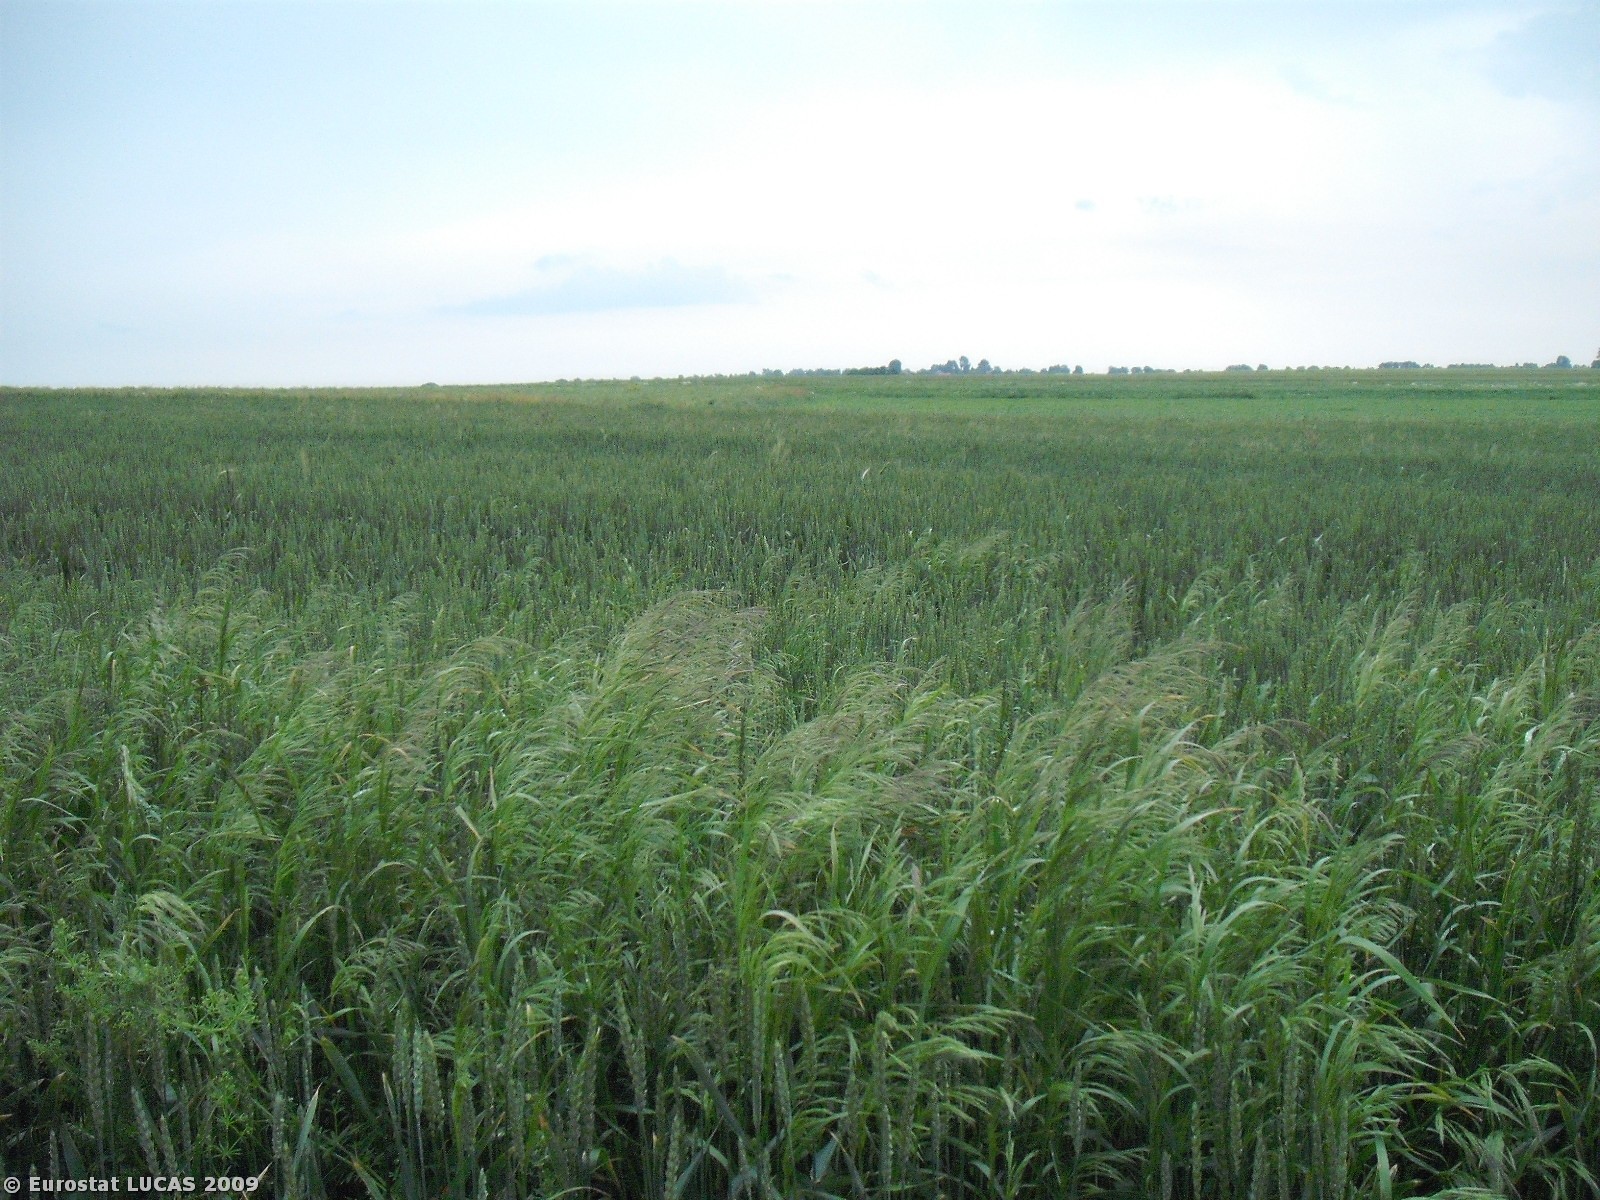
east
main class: Cropland
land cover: Rape and turnip rape
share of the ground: > 75 %
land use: Agriculture (excluding fallow land and kitchen gardens)
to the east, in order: Rape and turnip rape; Common wheat; Grass margins; Paved roads, cycling and walking lanes; Grass margins; Rape and turnip rape; Oats; Grassland without tree/shrub cover; Oats; Grass margins; Other root crops; Grass margins; Common wheat; Barley
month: June
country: PL
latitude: 50.7804
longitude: 21.3237
